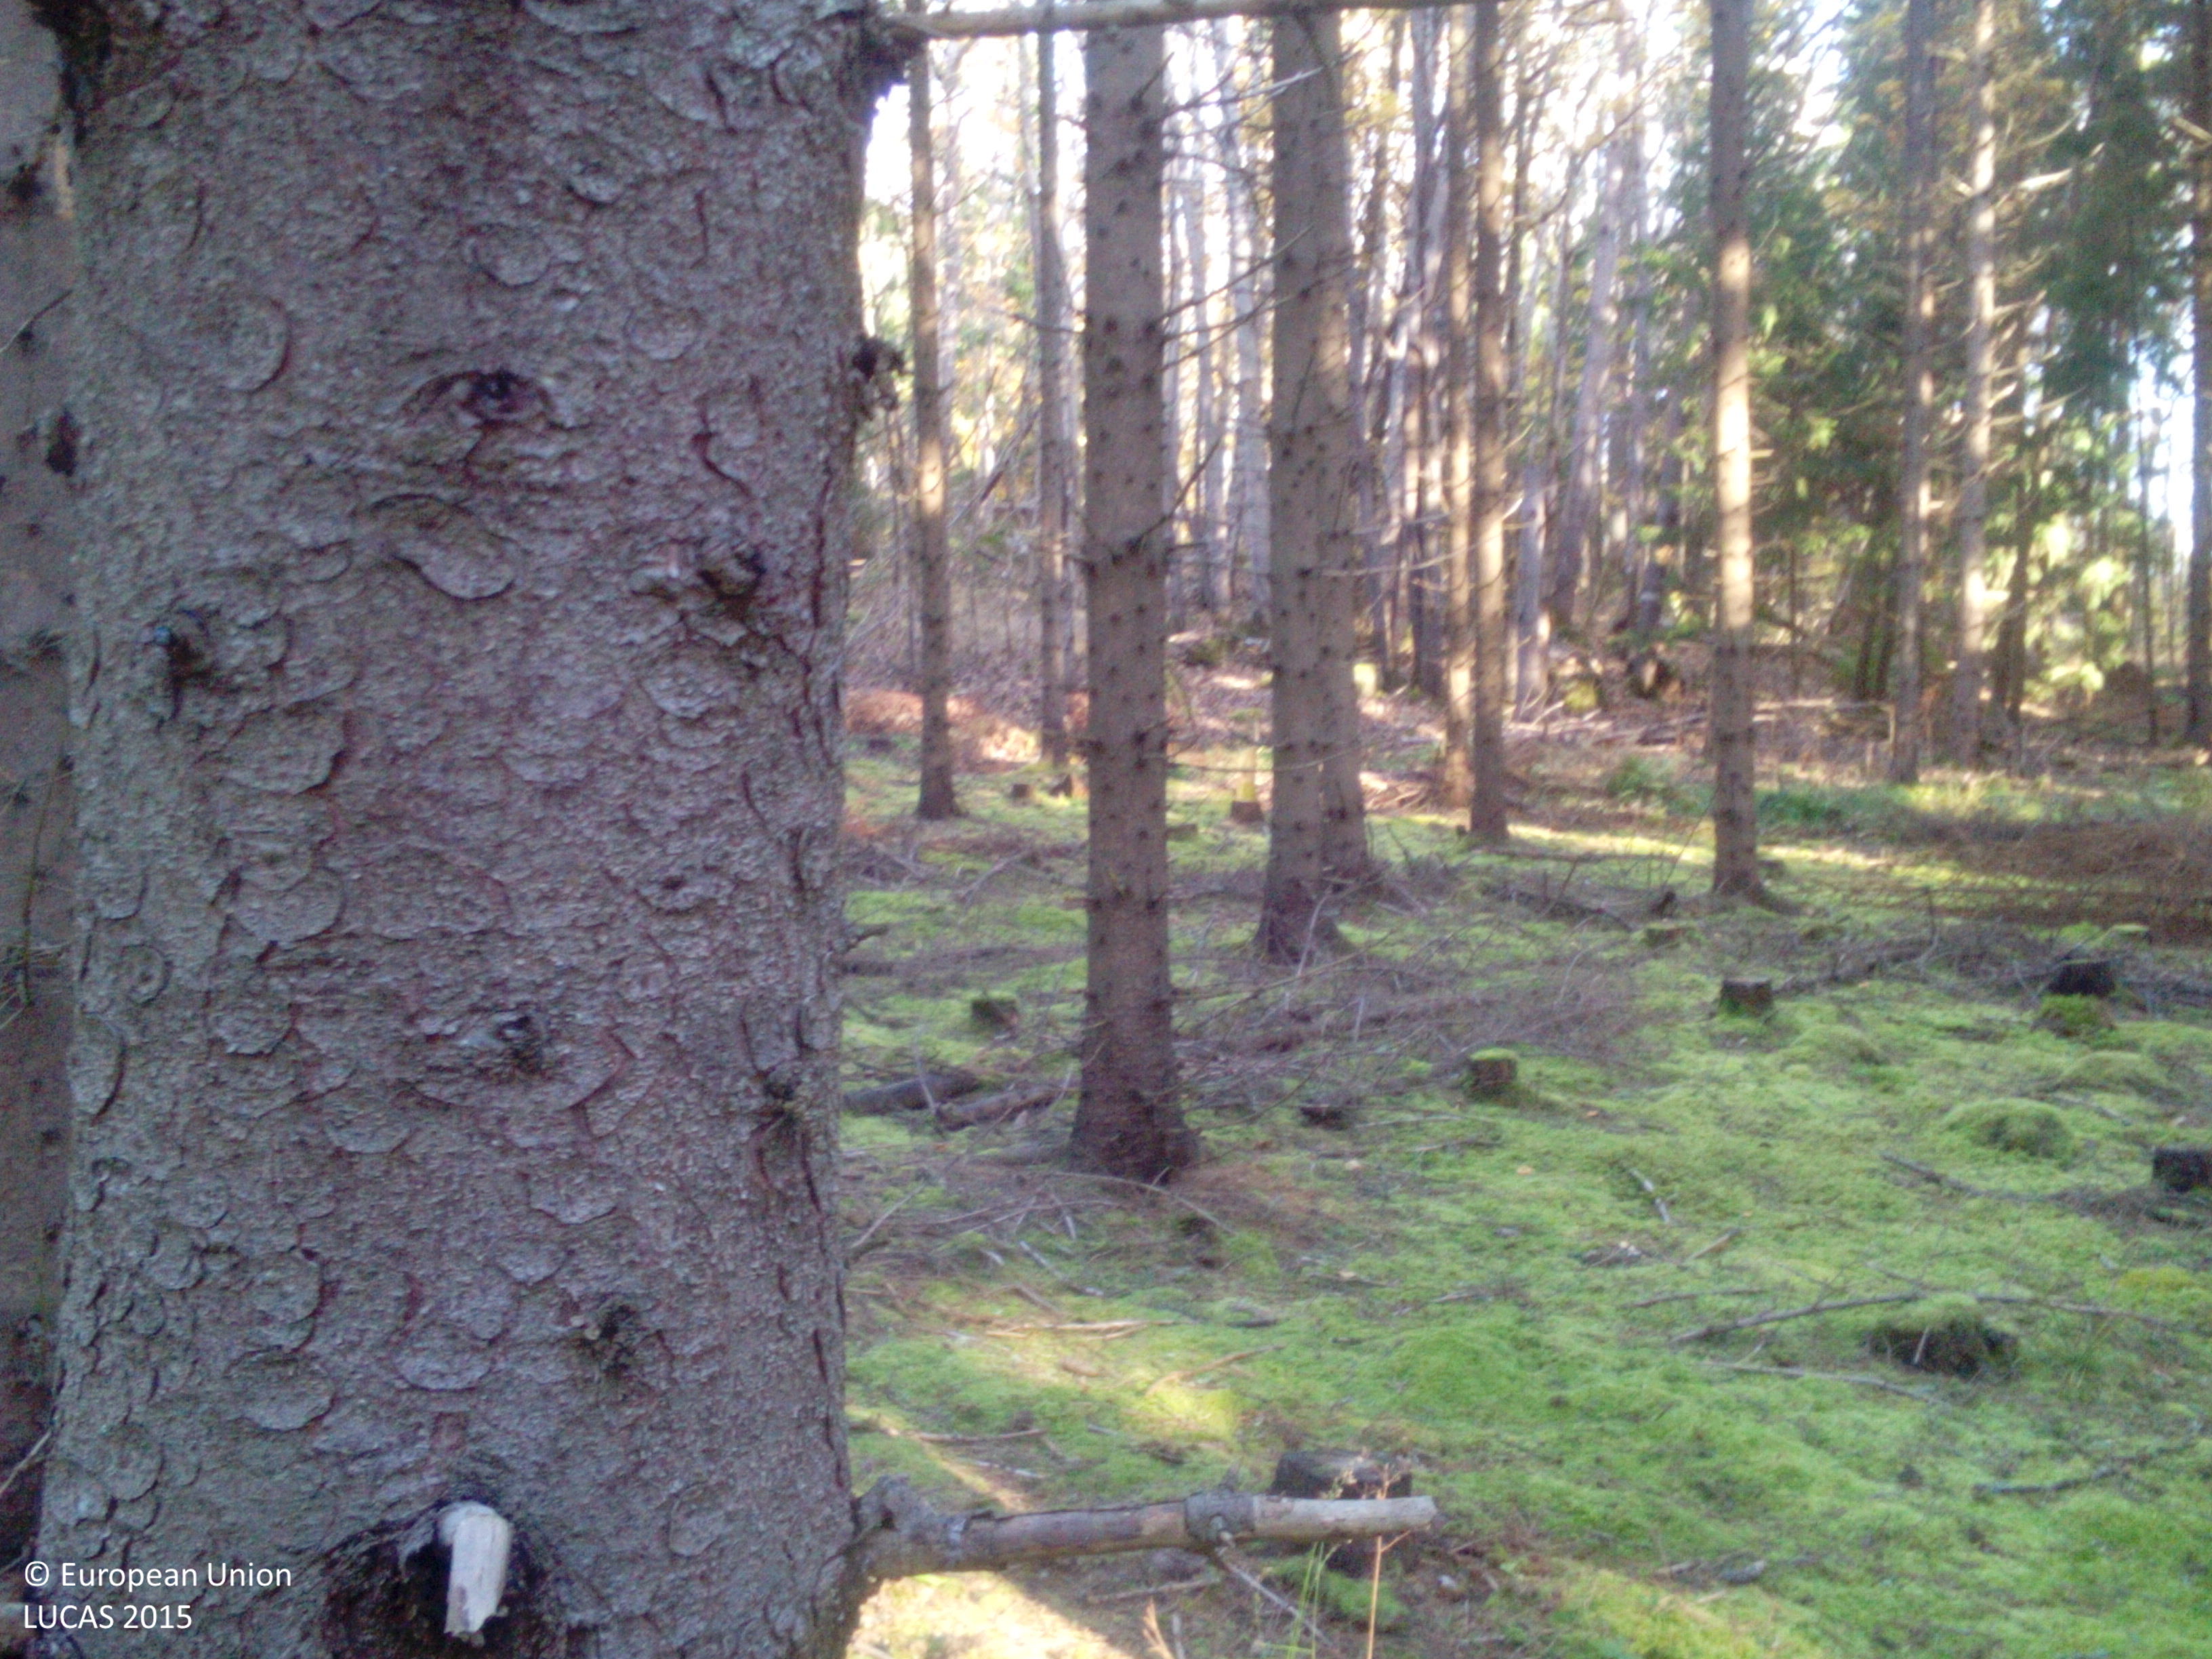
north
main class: Woodland
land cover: Spruce dominated coniferous woodland
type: boreal forest
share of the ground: > 75 %
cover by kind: coniferous forest trees 85 %, lichens and mosses 10 %, herbaceous plants 5 %
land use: Forestry
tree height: > 5 m
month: October
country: SE
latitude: 59.0343
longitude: 16.5635
